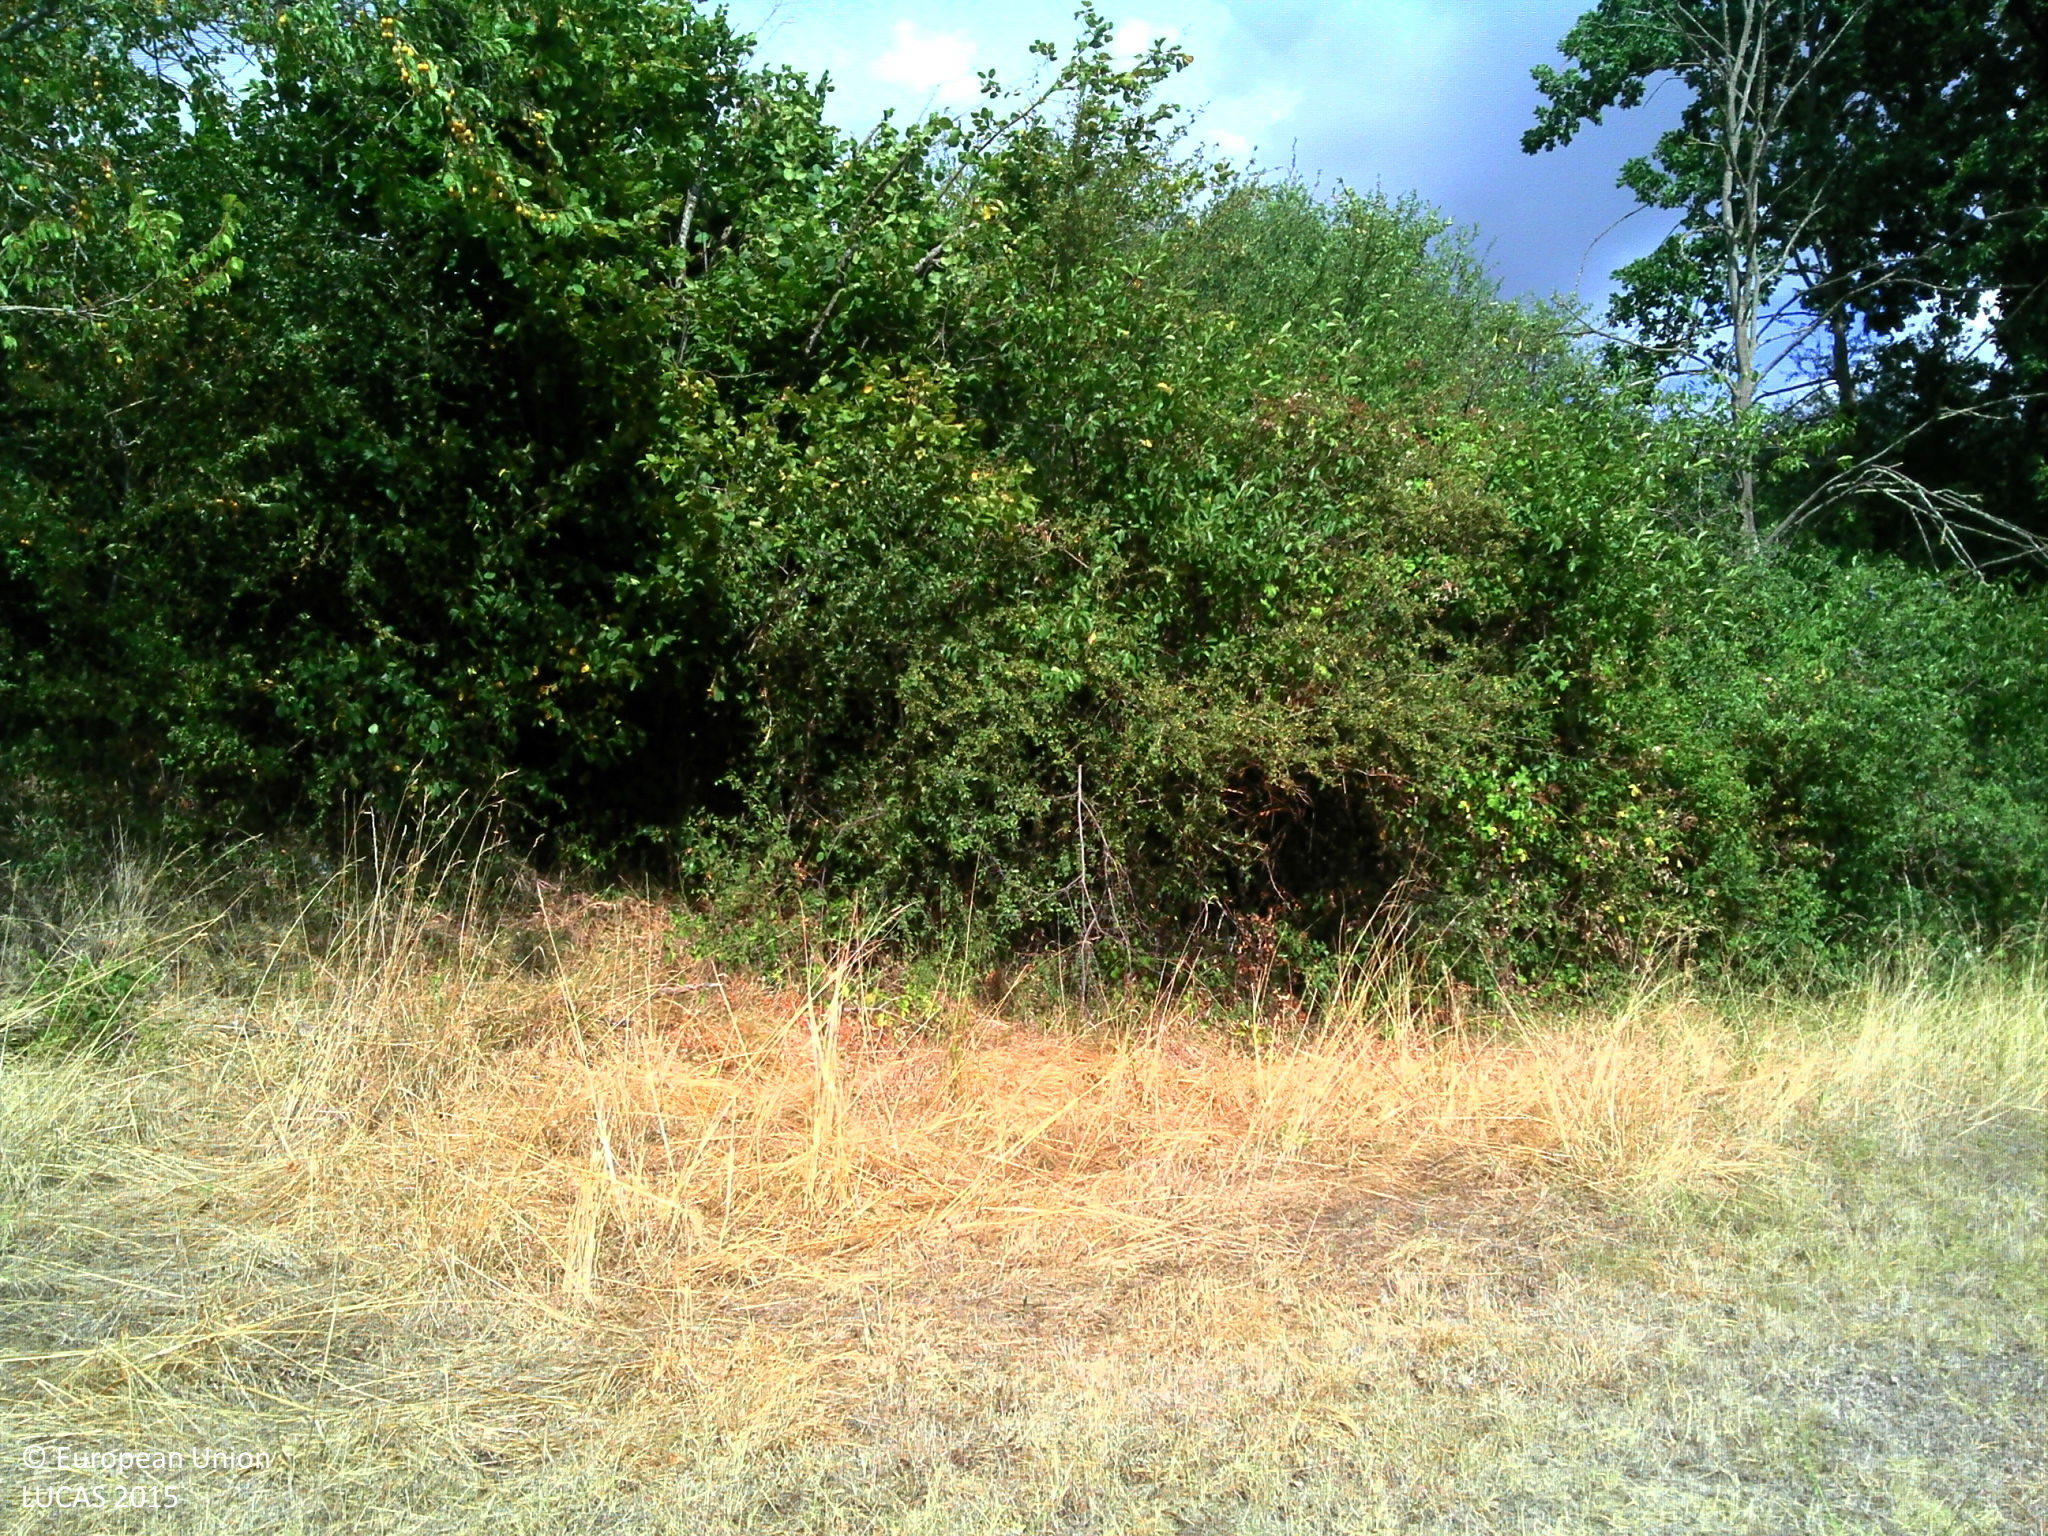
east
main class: Grassland
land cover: Grassland without tree/shrub cover
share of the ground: > 75 %
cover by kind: herbaceous plants 100 %
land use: Agriculture (excluding fallow land and kitchen gardens)
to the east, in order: Grassland without tree/shrub cover; Fences; Broadleaved woodland; Other fruit trees and berries; Grassland without tree/shrub cover; Fences; Grassland with sparse tree/shrub cover; Fences; Single bushes/trees; Tracks; Fences; Grassland without tree/shrub cover; Fences; Electric lines; Grass margins; Paved roads, cycling and walking lanes
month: July
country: FR
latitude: 44.4498
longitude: 0.6062
